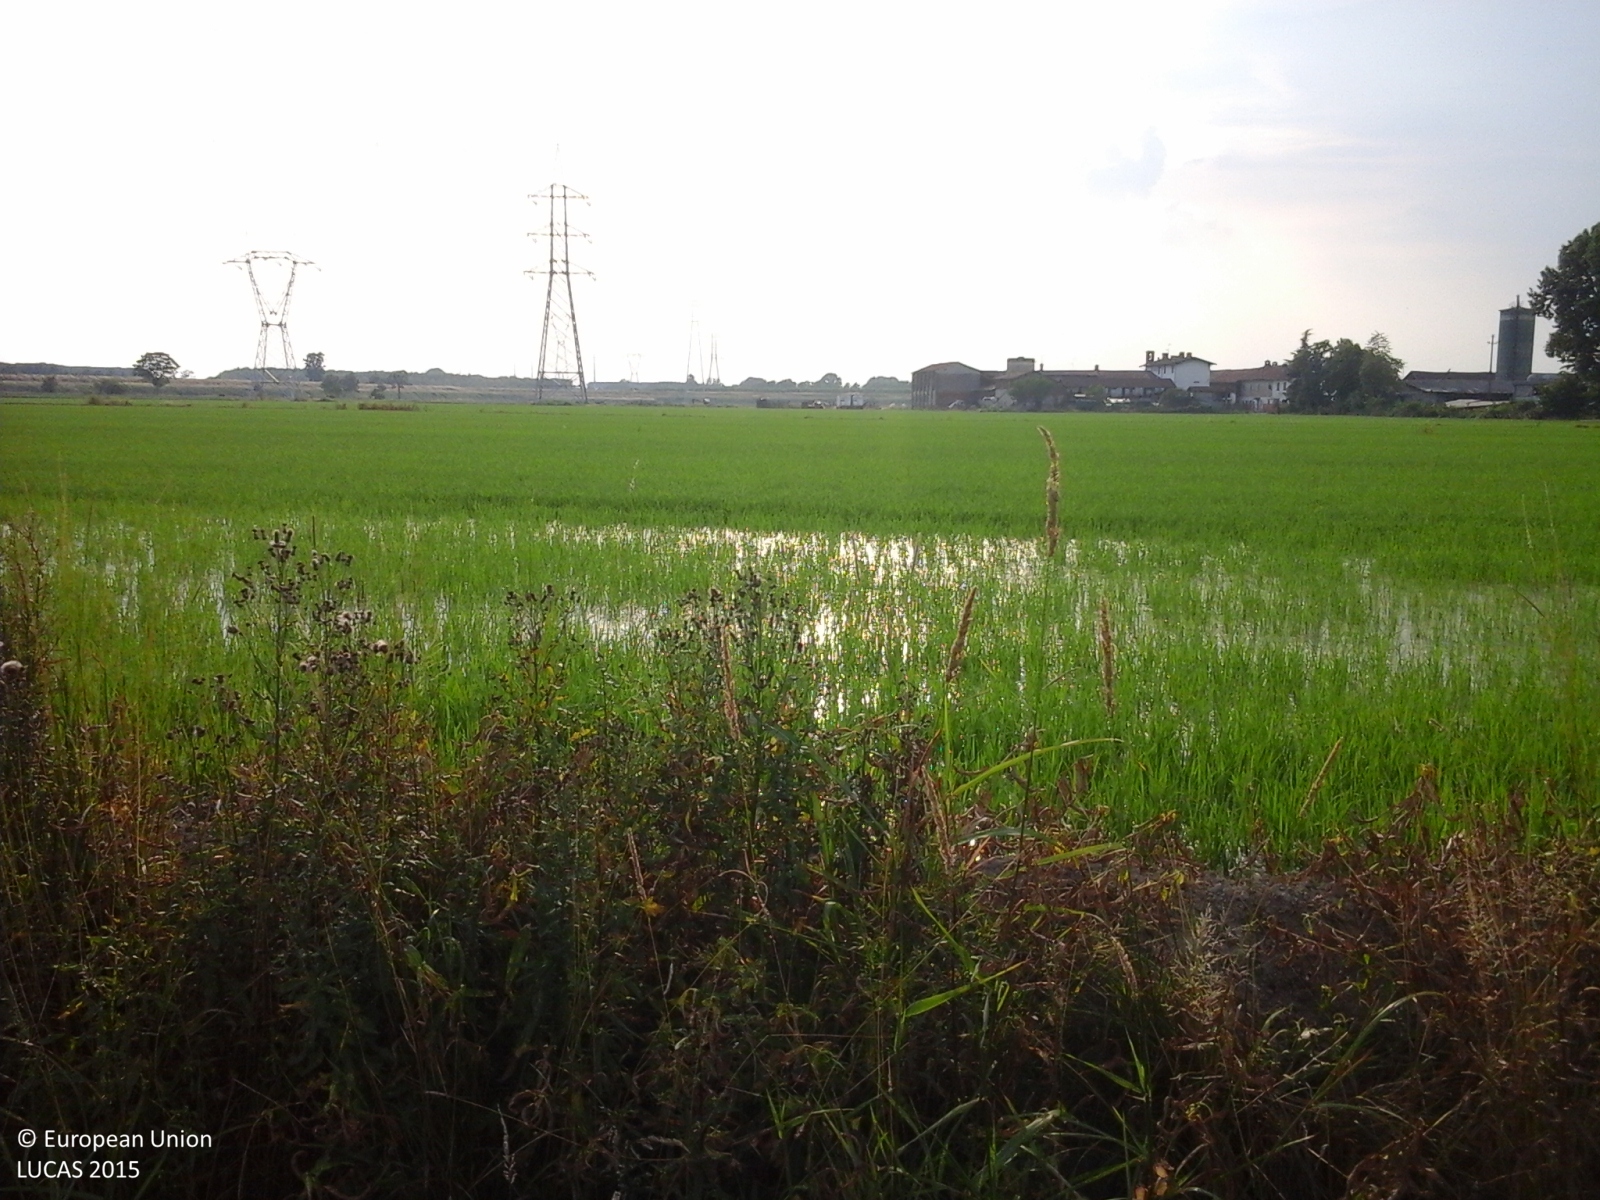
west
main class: Cropland
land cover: Rice
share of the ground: > 75 %
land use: Agriculture (excluding fallow land and kitchen gardens)
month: June
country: IT
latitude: 45.1430
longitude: 9.5557
